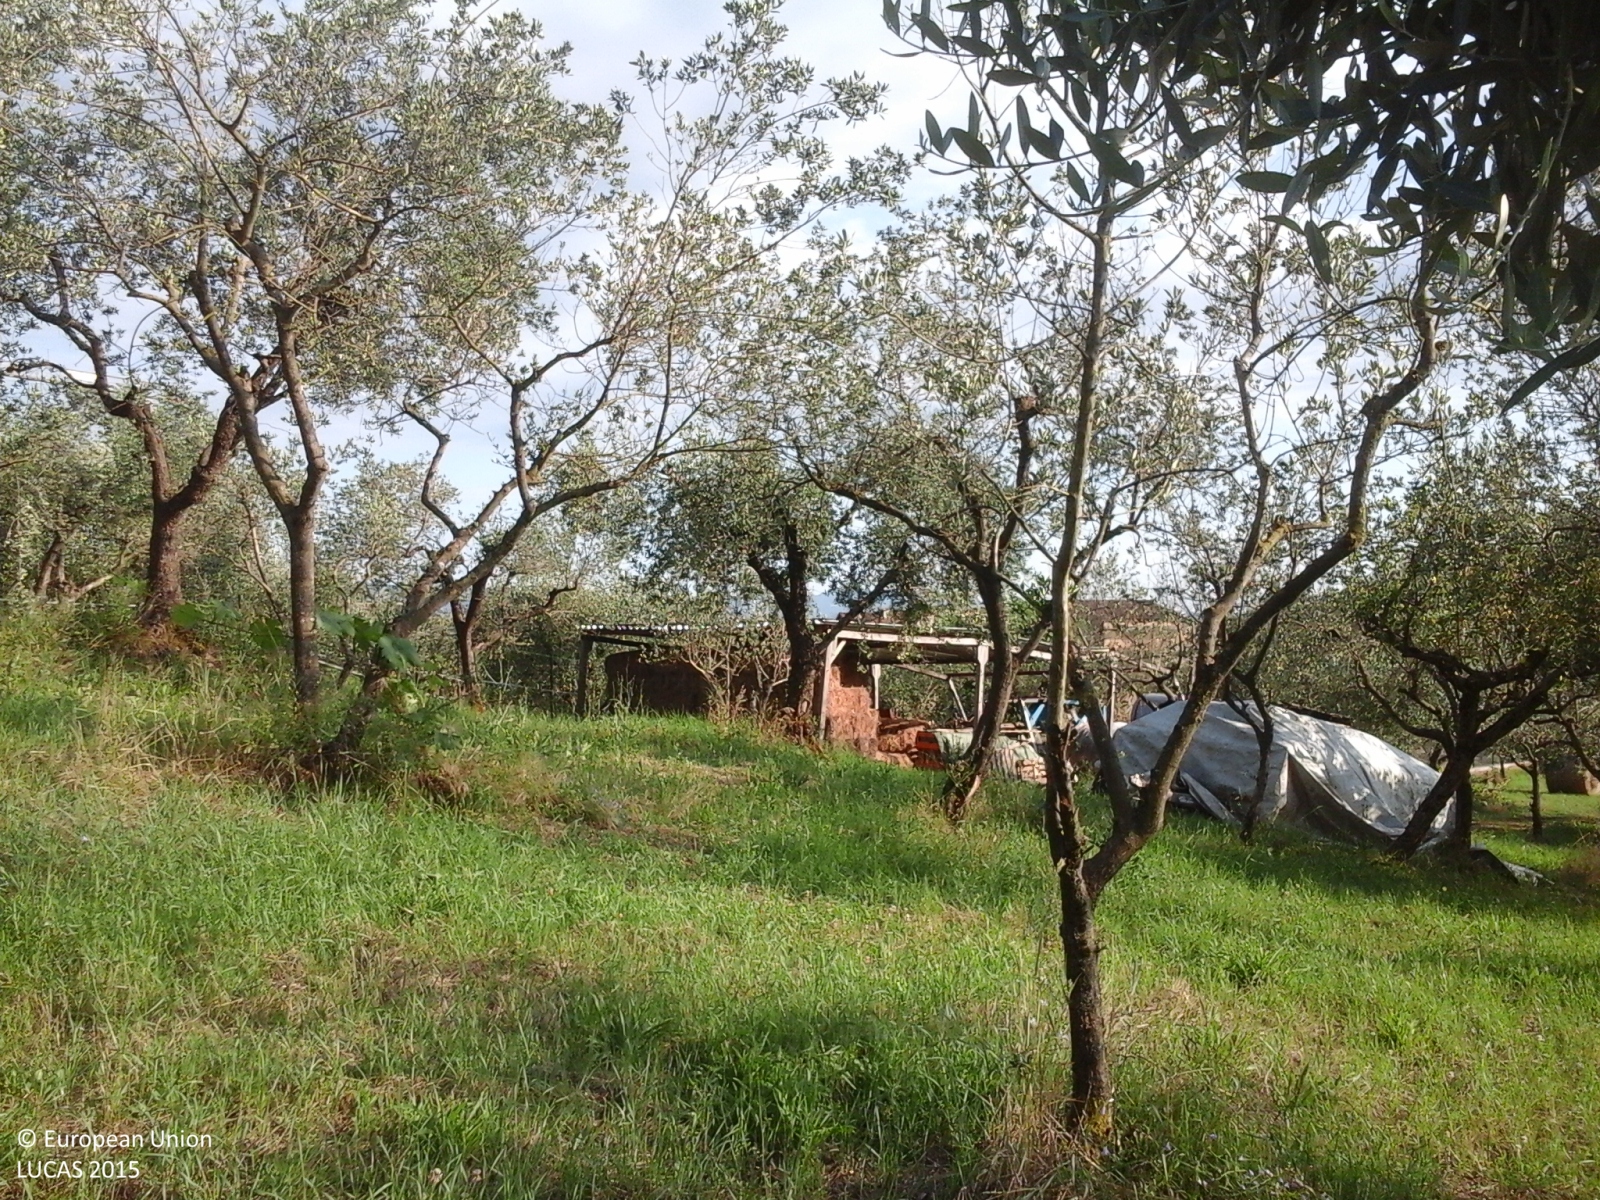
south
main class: Cropland
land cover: Olive groves
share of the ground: 25 - 50 %
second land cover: Grassland without tree/shrub cover
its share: > 75 %
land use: Agriculture (excluding fallow land and kitchen gardens)
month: June
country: IT
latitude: 41.8102
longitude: 13.1301
